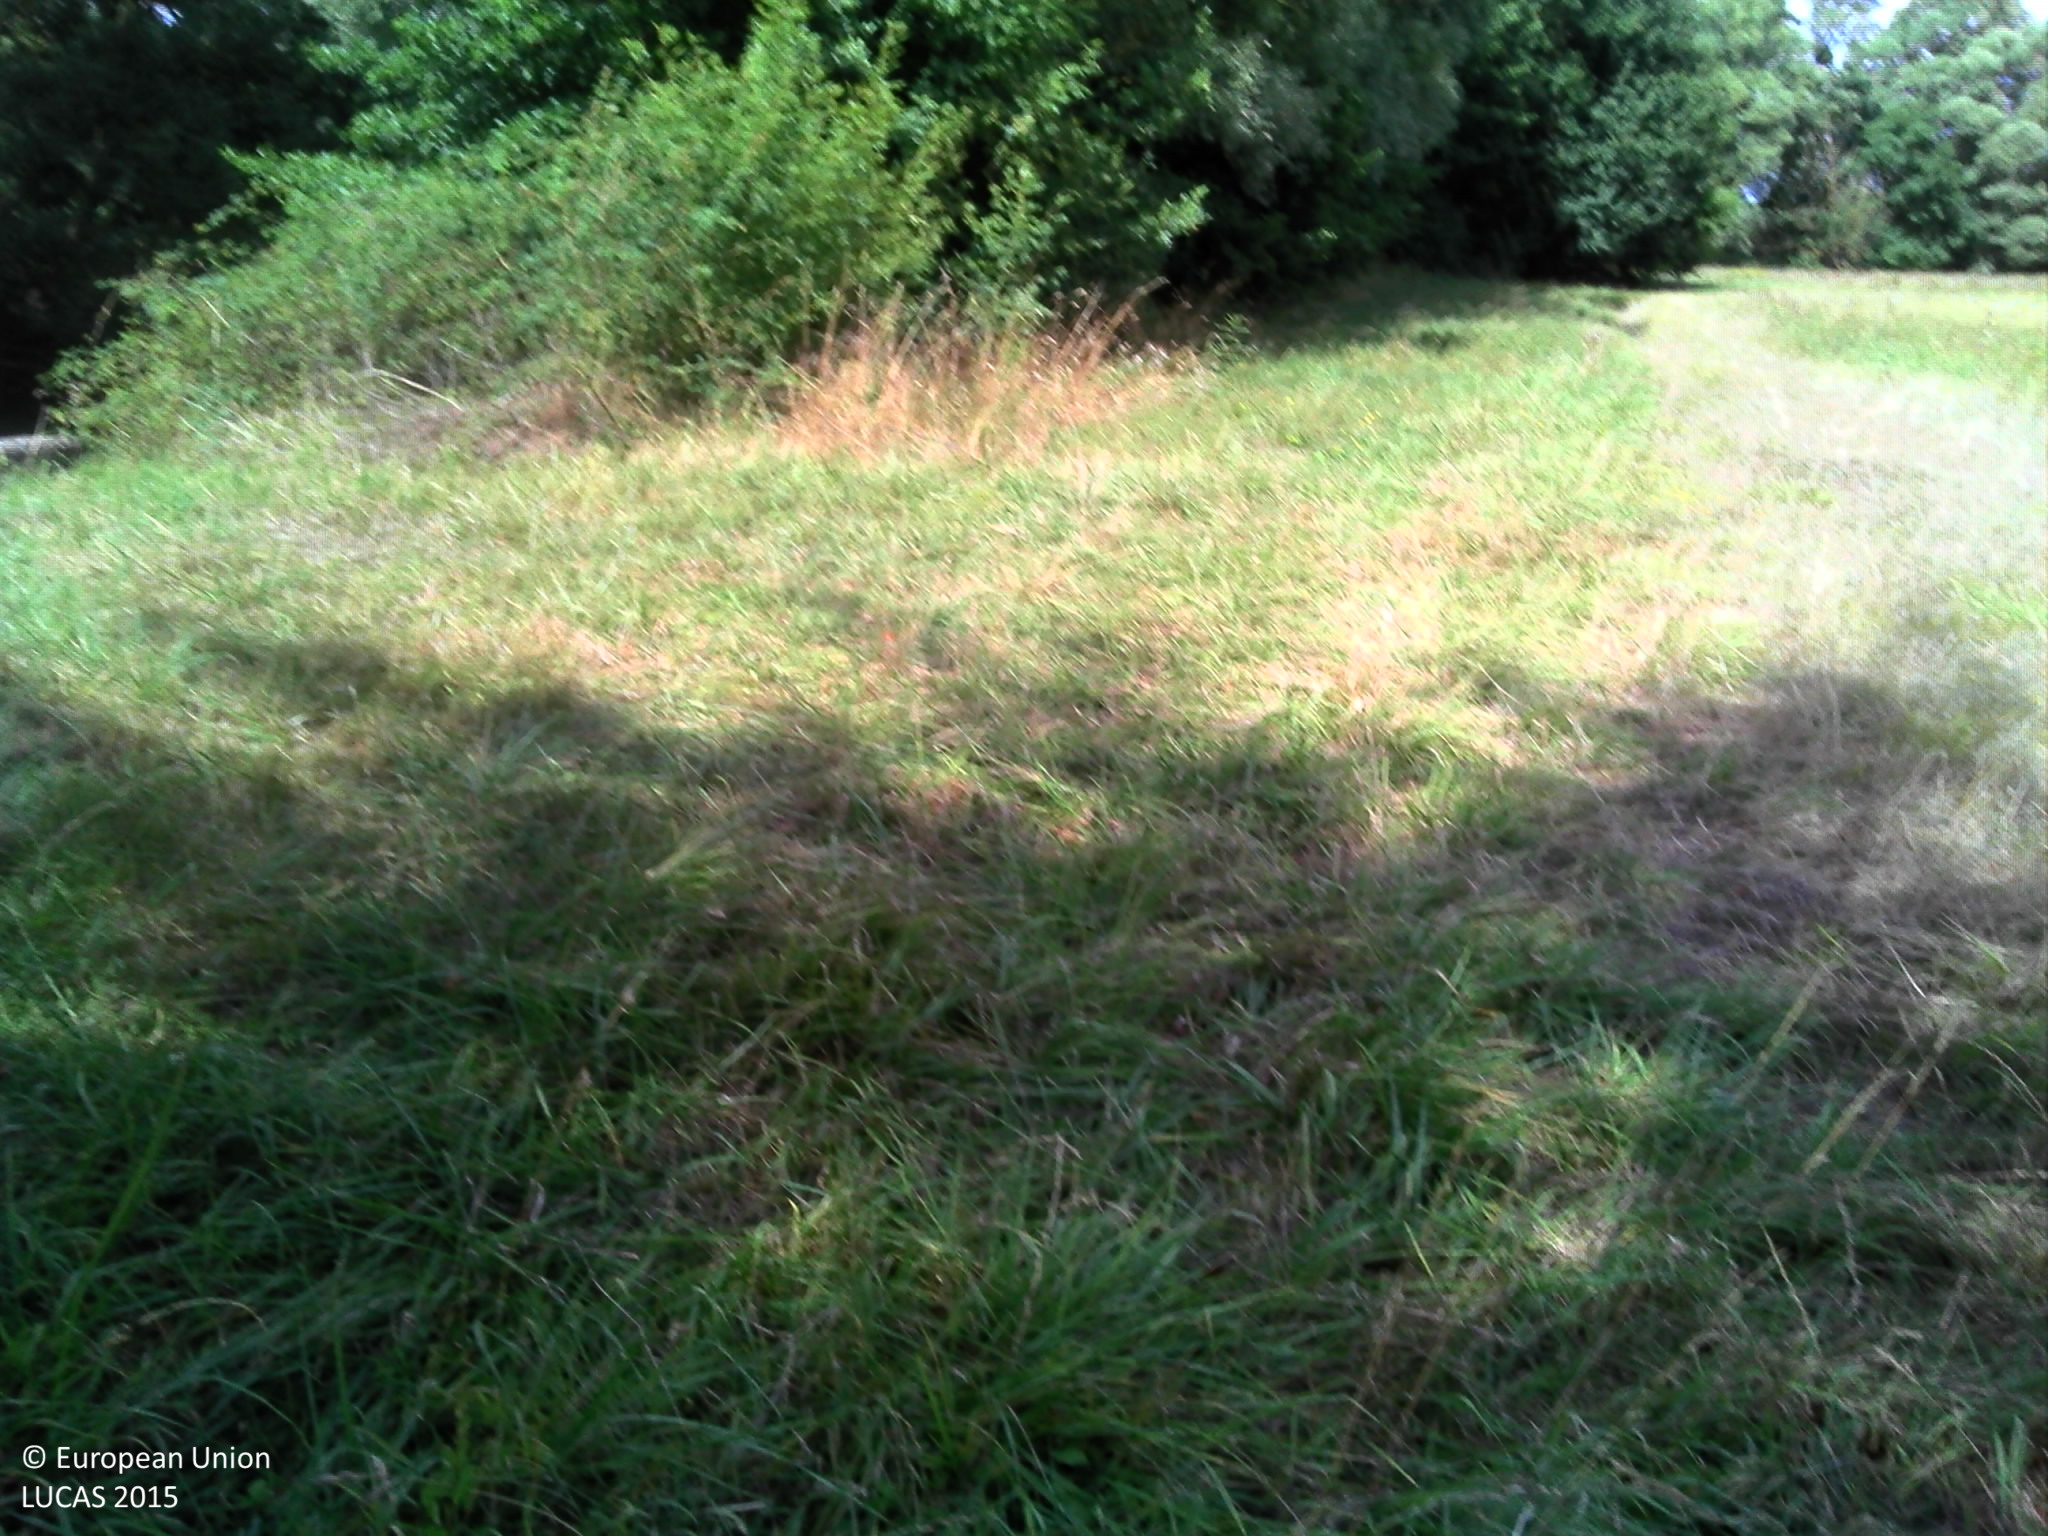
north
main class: Grassland
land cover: Grassland without tree/shrub cover
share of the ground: > 75 %
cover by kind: herbaceous plants 100 %
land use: Agriculture (excluding fallow land and kitchen gardens)
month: July
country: FR
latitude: 46.9826
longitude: 2.1166
